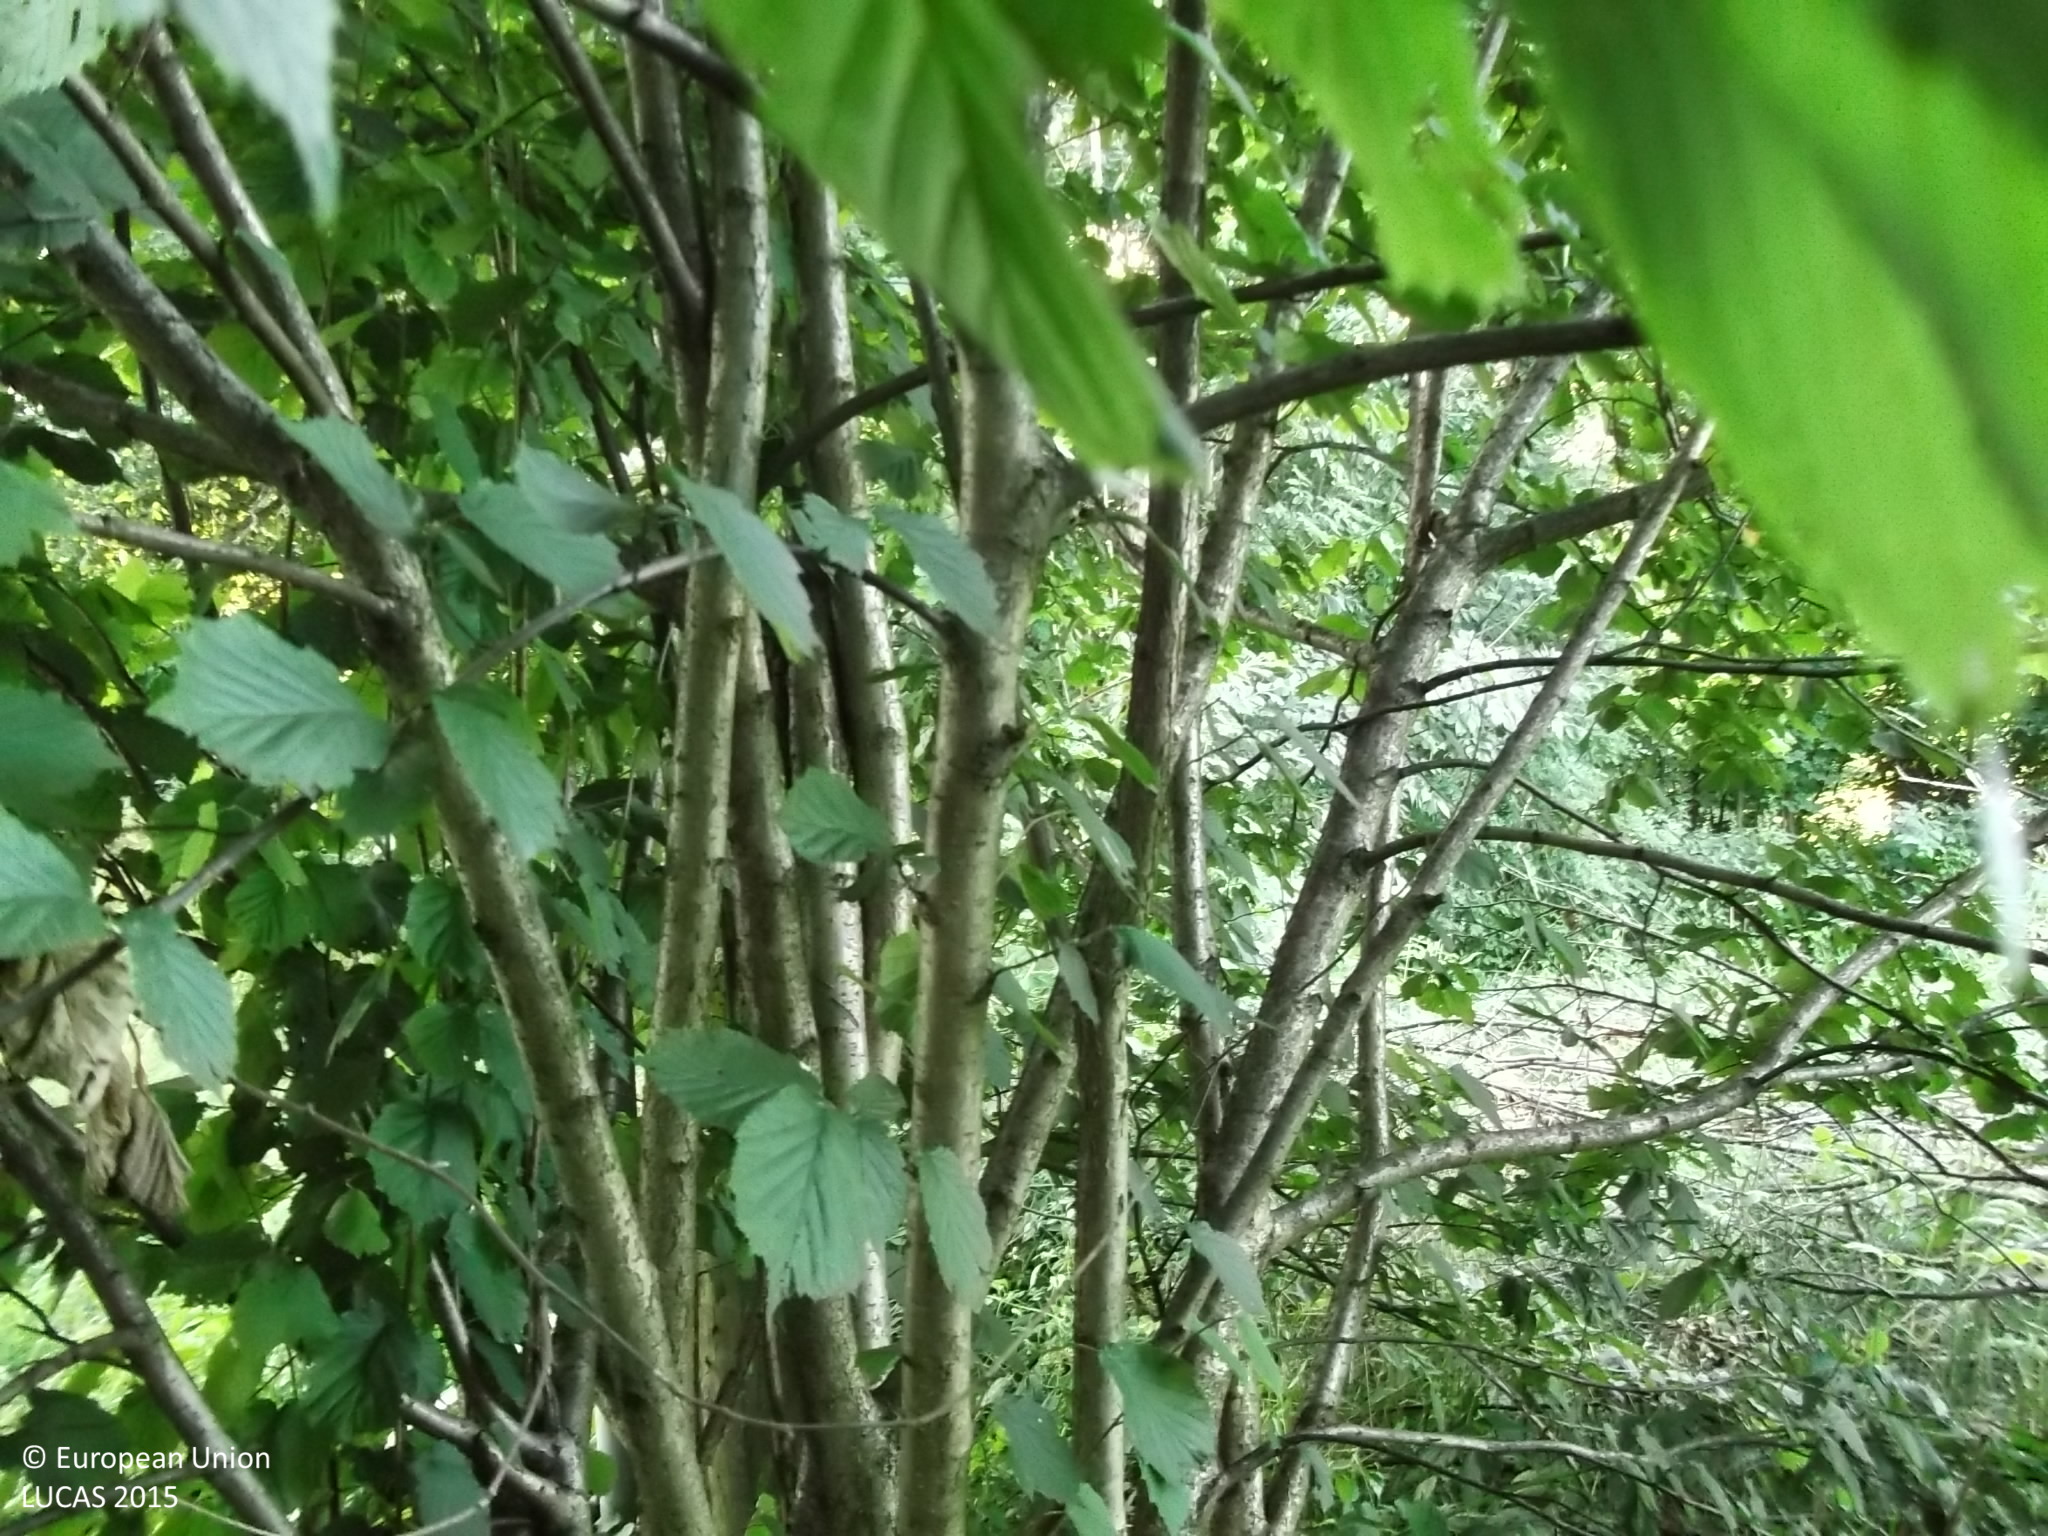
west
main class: Woodland
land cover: Broadleaved woodland
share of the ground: > 75 %
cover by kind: broadleaved forest trees 80 %, coniferous forest trees 10 %, shrubs 5 %, herbaceous plants 5 %
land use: Forestry
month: July
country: AT
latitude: 47.9211
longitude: 13.3310
